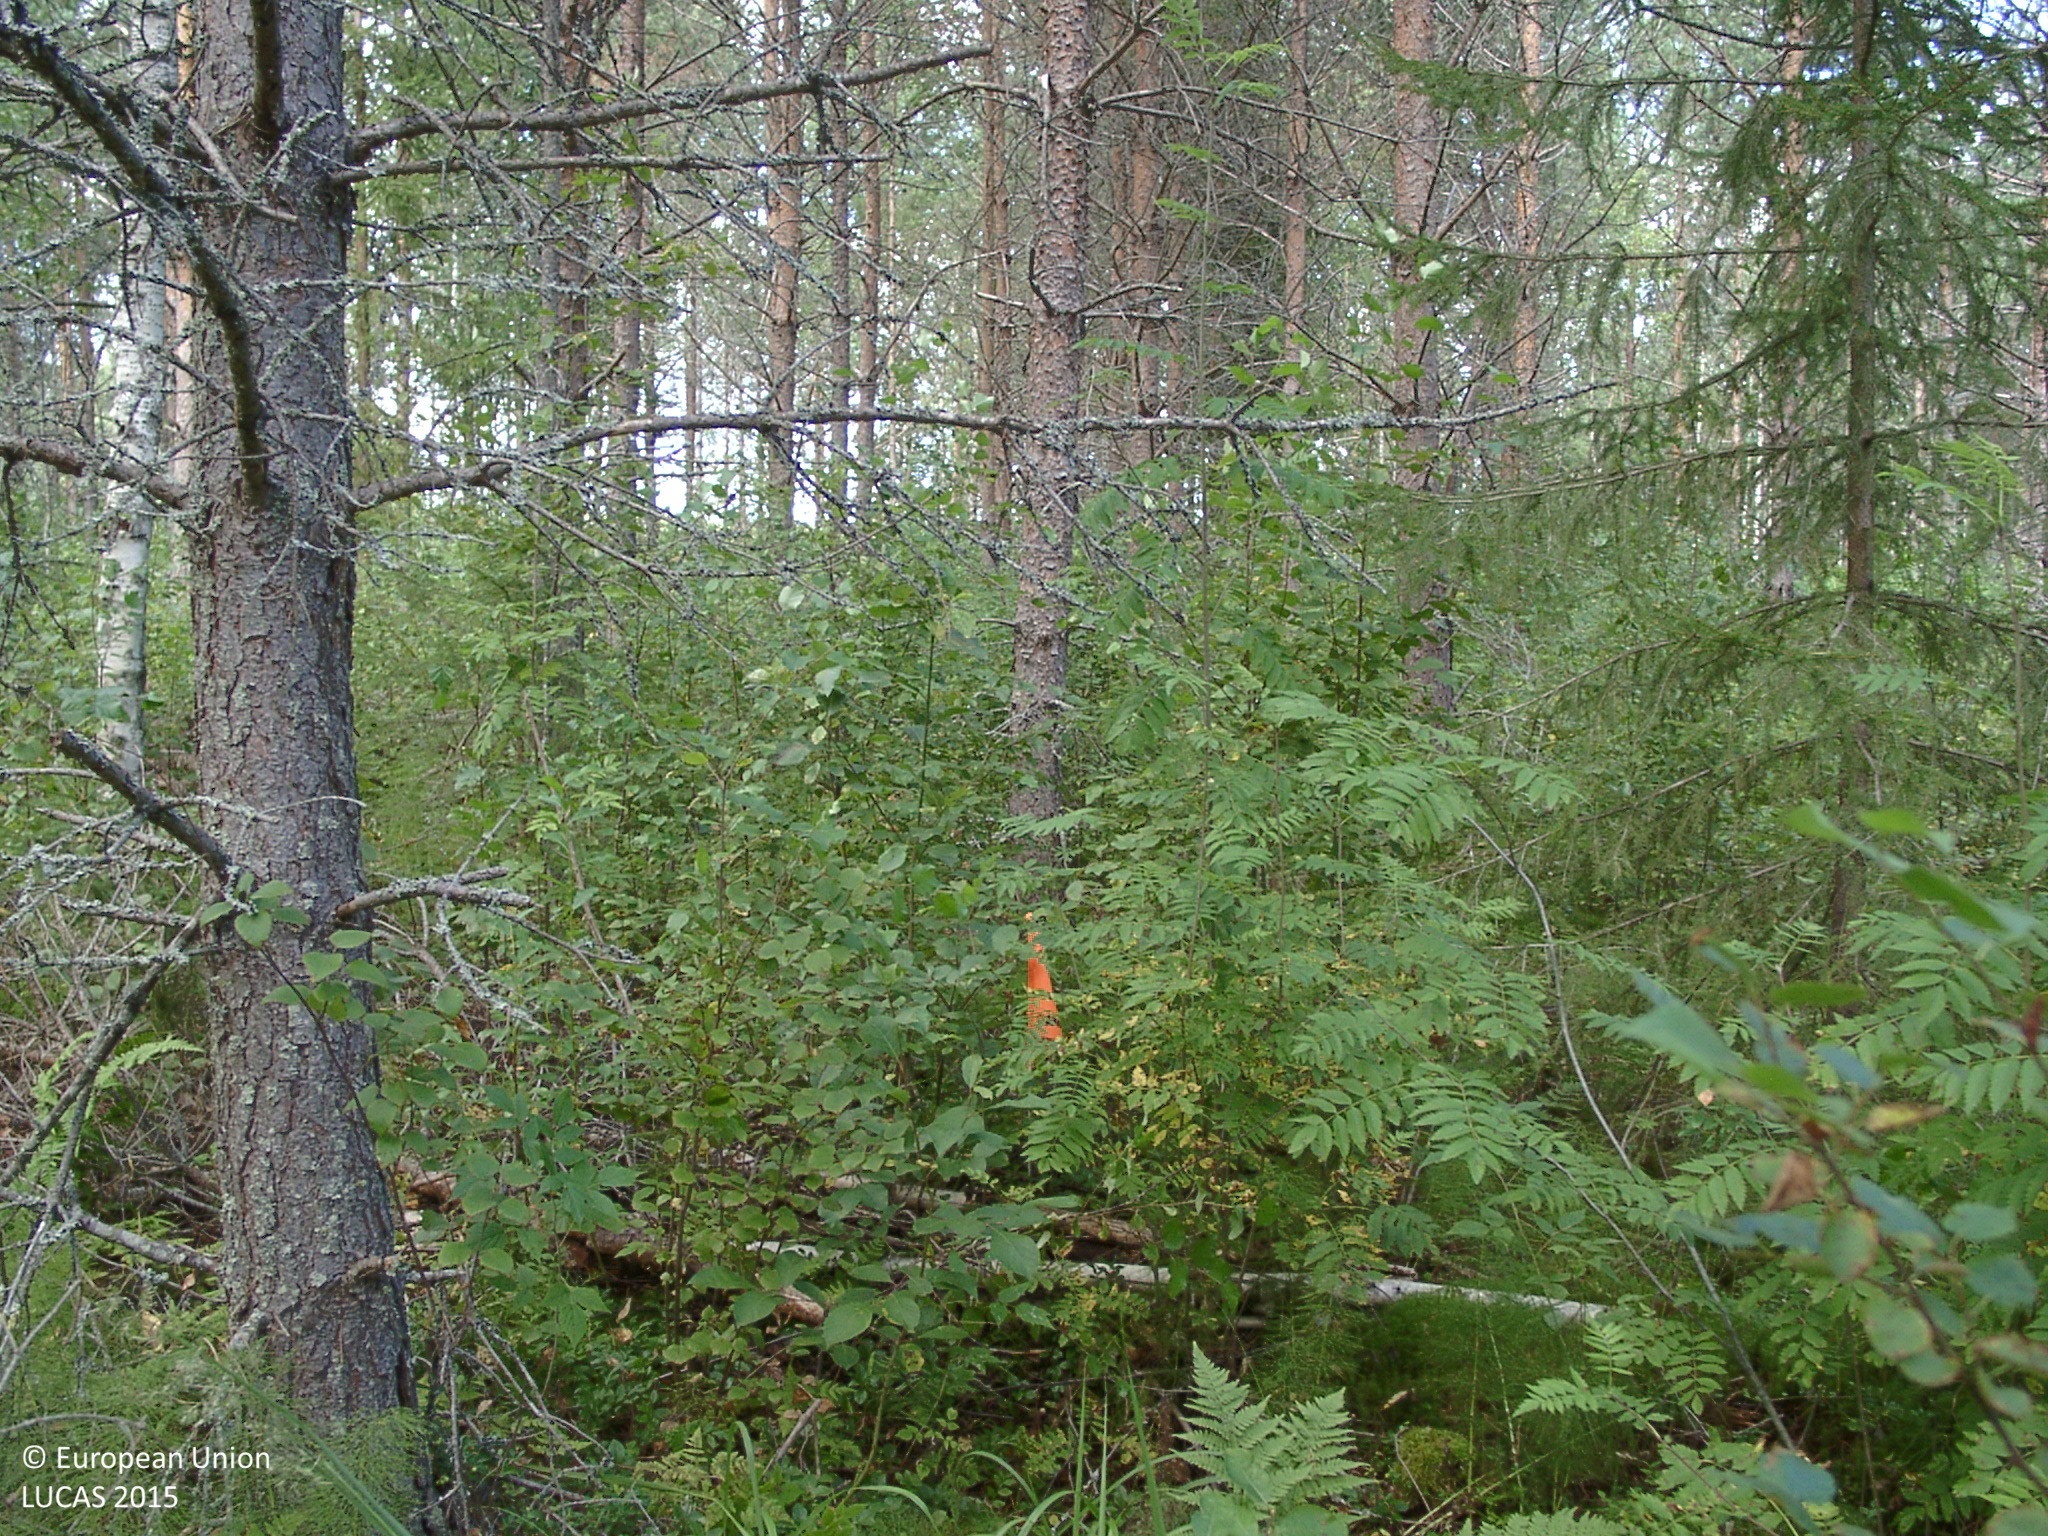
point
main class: Woodland
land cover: Pine dominated coniferous woodland
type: boreal forest
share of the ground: > 75 %
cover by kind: coniferous forest trees 60 %, broadleaved forest trees 15 %, shrubs 10 %, herbaceous plants 10 %
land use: Forestry
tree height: > 5 m
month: August
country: FI
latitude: 62.3737
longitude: 25.6787
